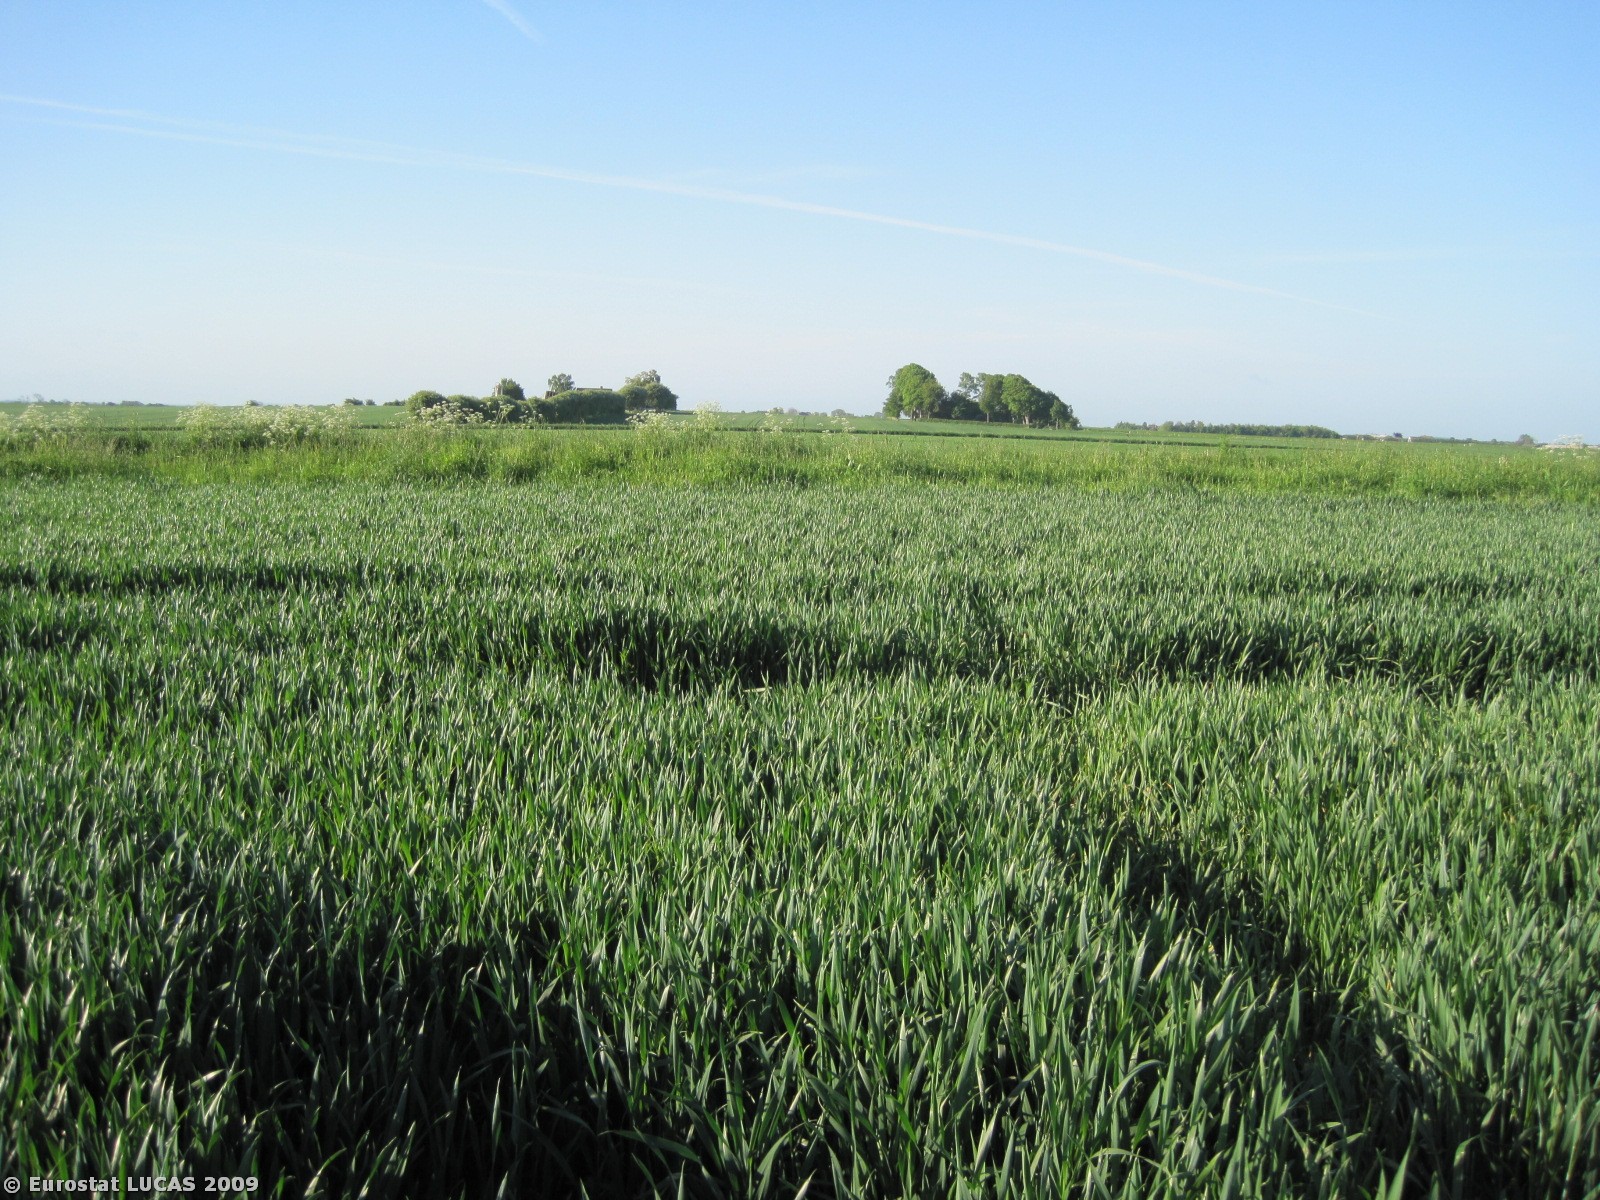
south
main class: Cropland
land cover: Common wheat
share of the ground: > 75 %
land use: Agriculture (excluding fallow land and kitchen gardens)
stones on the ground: < 10 %
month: May
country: DK
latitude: 56.6190
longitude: 10.2116
